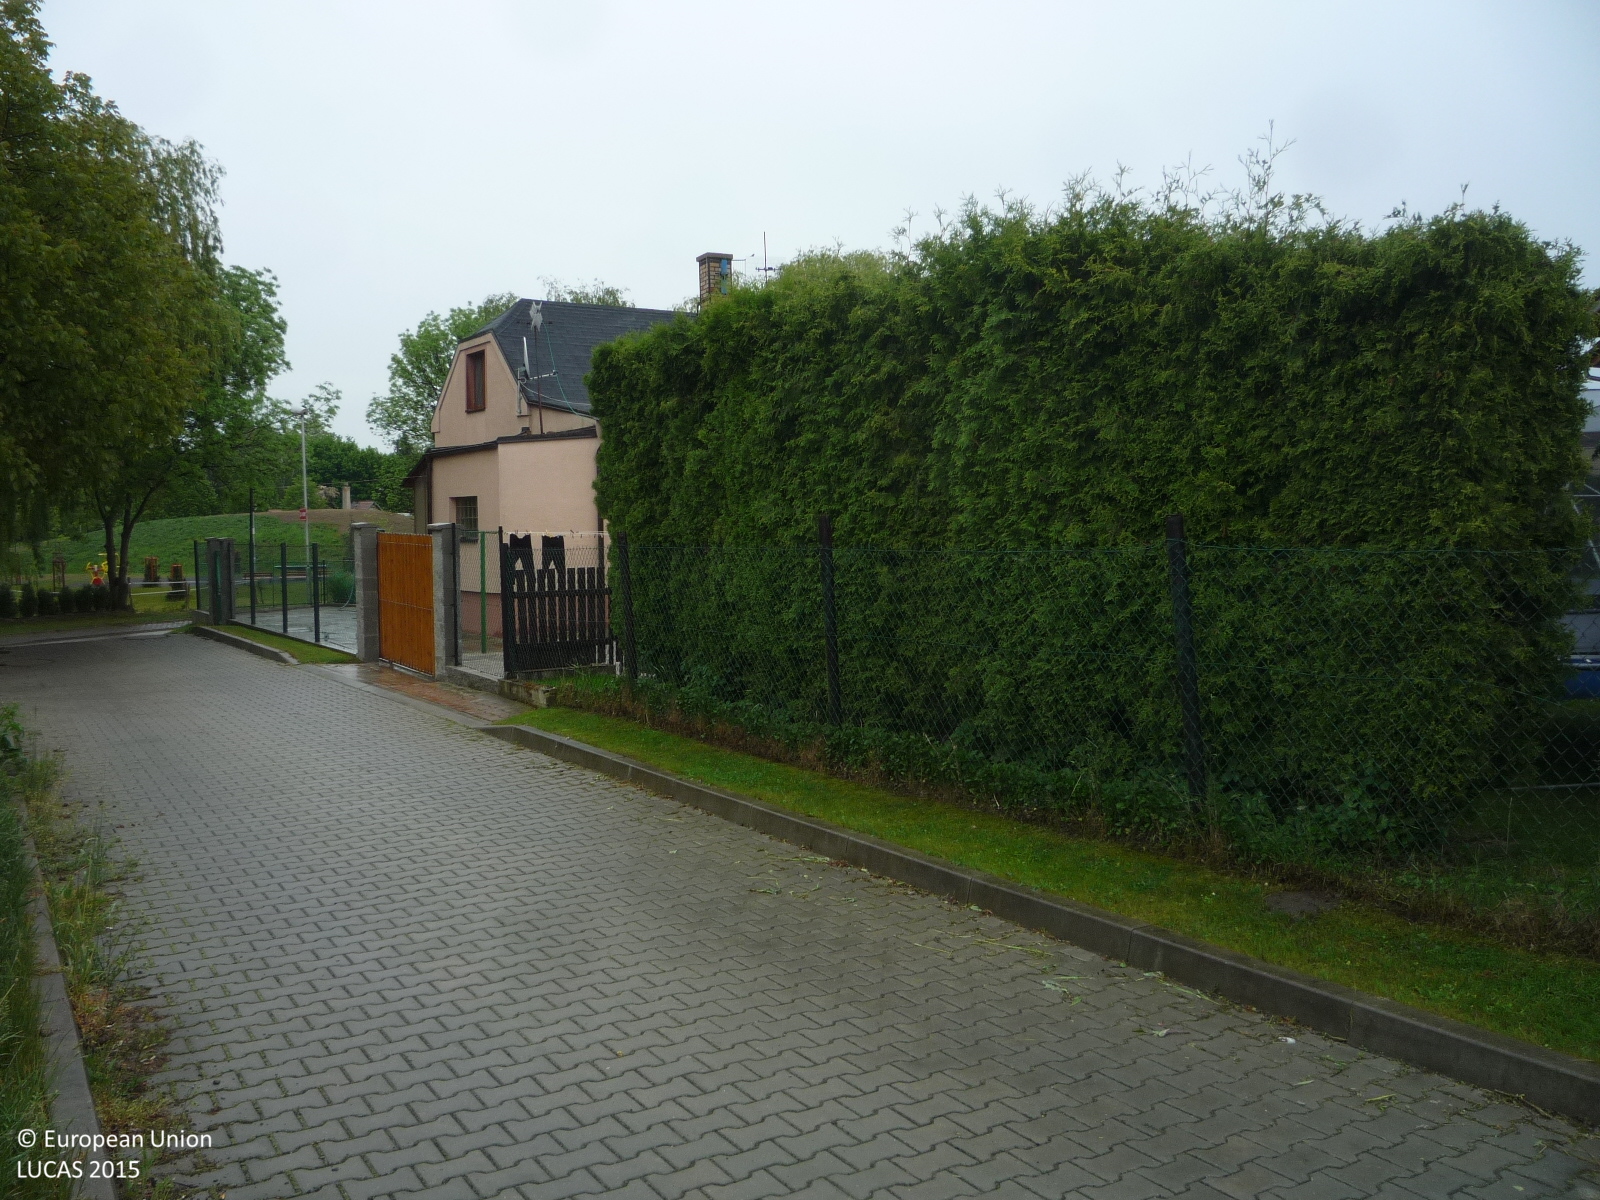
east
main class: Grassland
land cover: Grassland without tree/shrub cover
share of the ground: > 75 %
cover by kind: herbaceous plants 100 %
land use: Logistics and storage
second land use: Waste treatment
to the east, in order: Grassland without tree/shrub cover; Artificial constructions in urban areas; Ditches and canals; Artificial constructions in urban areas; Ditches and canals; Artificial constructions in urban areas
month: May
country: CZ
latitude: 50.1453
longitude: 14.6058
